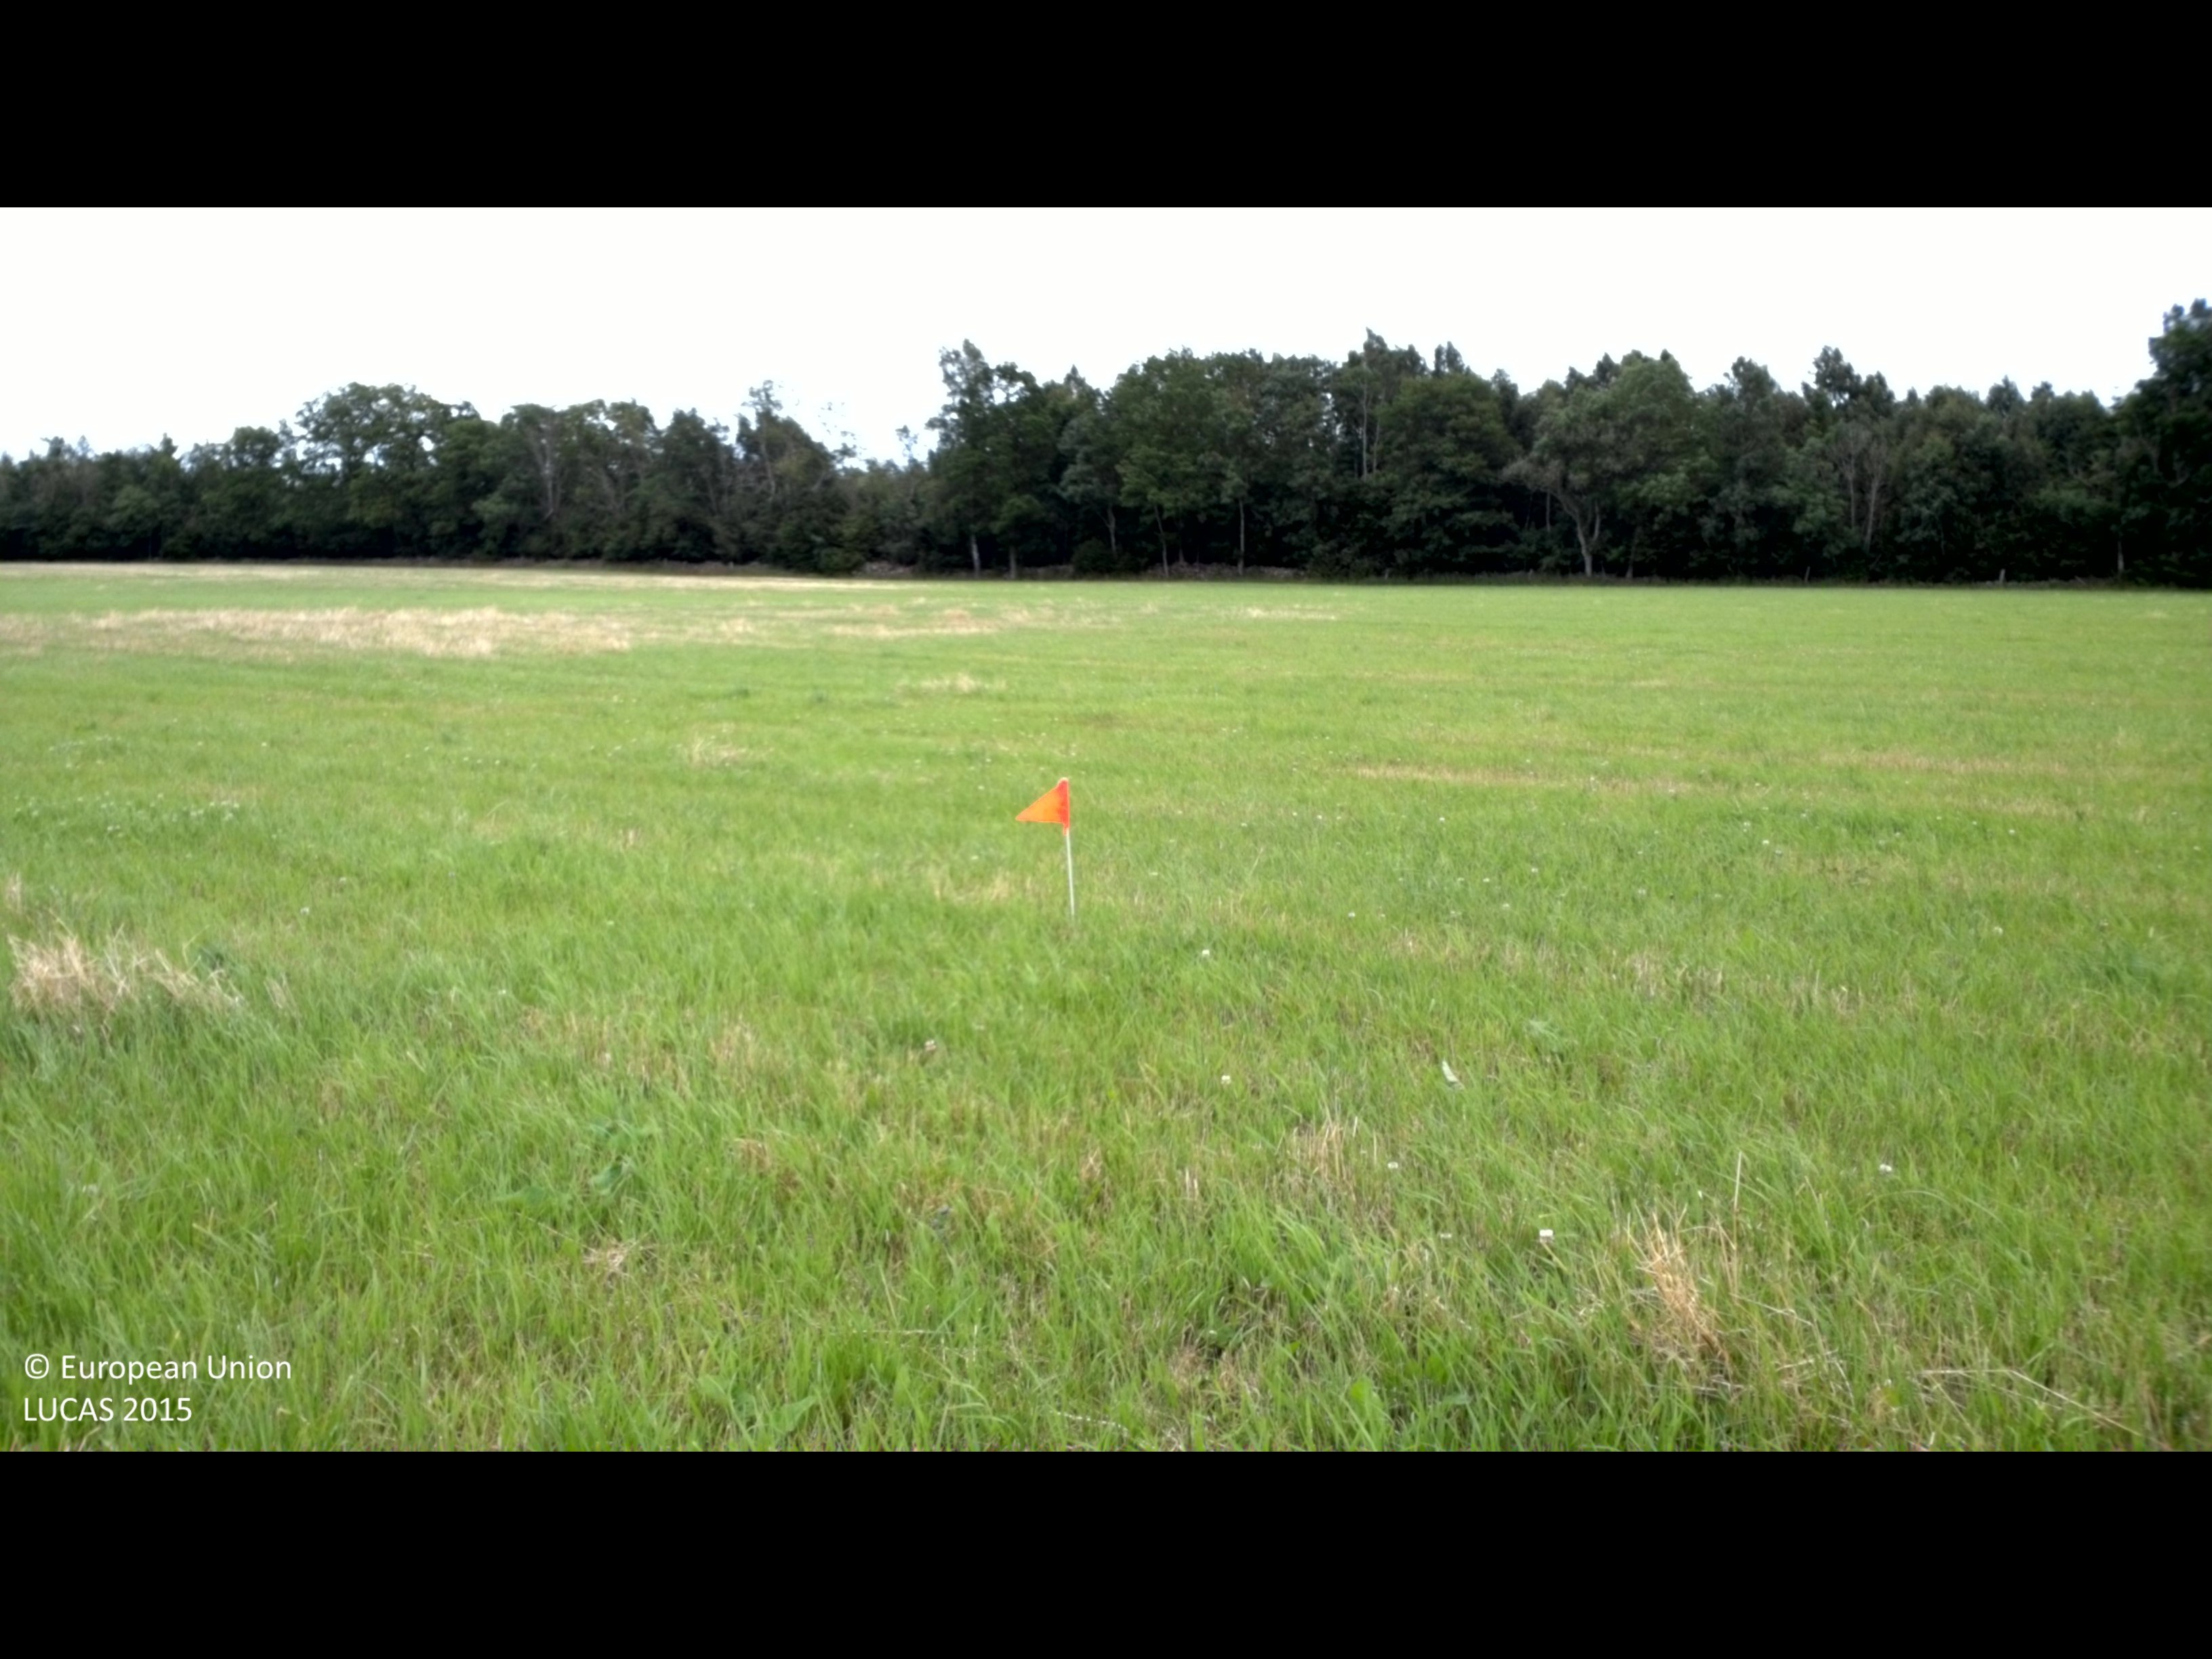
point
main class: Cropland
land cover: Other leguminous and mixtures for fodder
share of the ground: > 75 %
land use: Agriculture (excluding fallow land and kitchen gardens)
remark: Harvested field
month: July
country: SE
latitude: 56.7061
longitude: 16.5514
